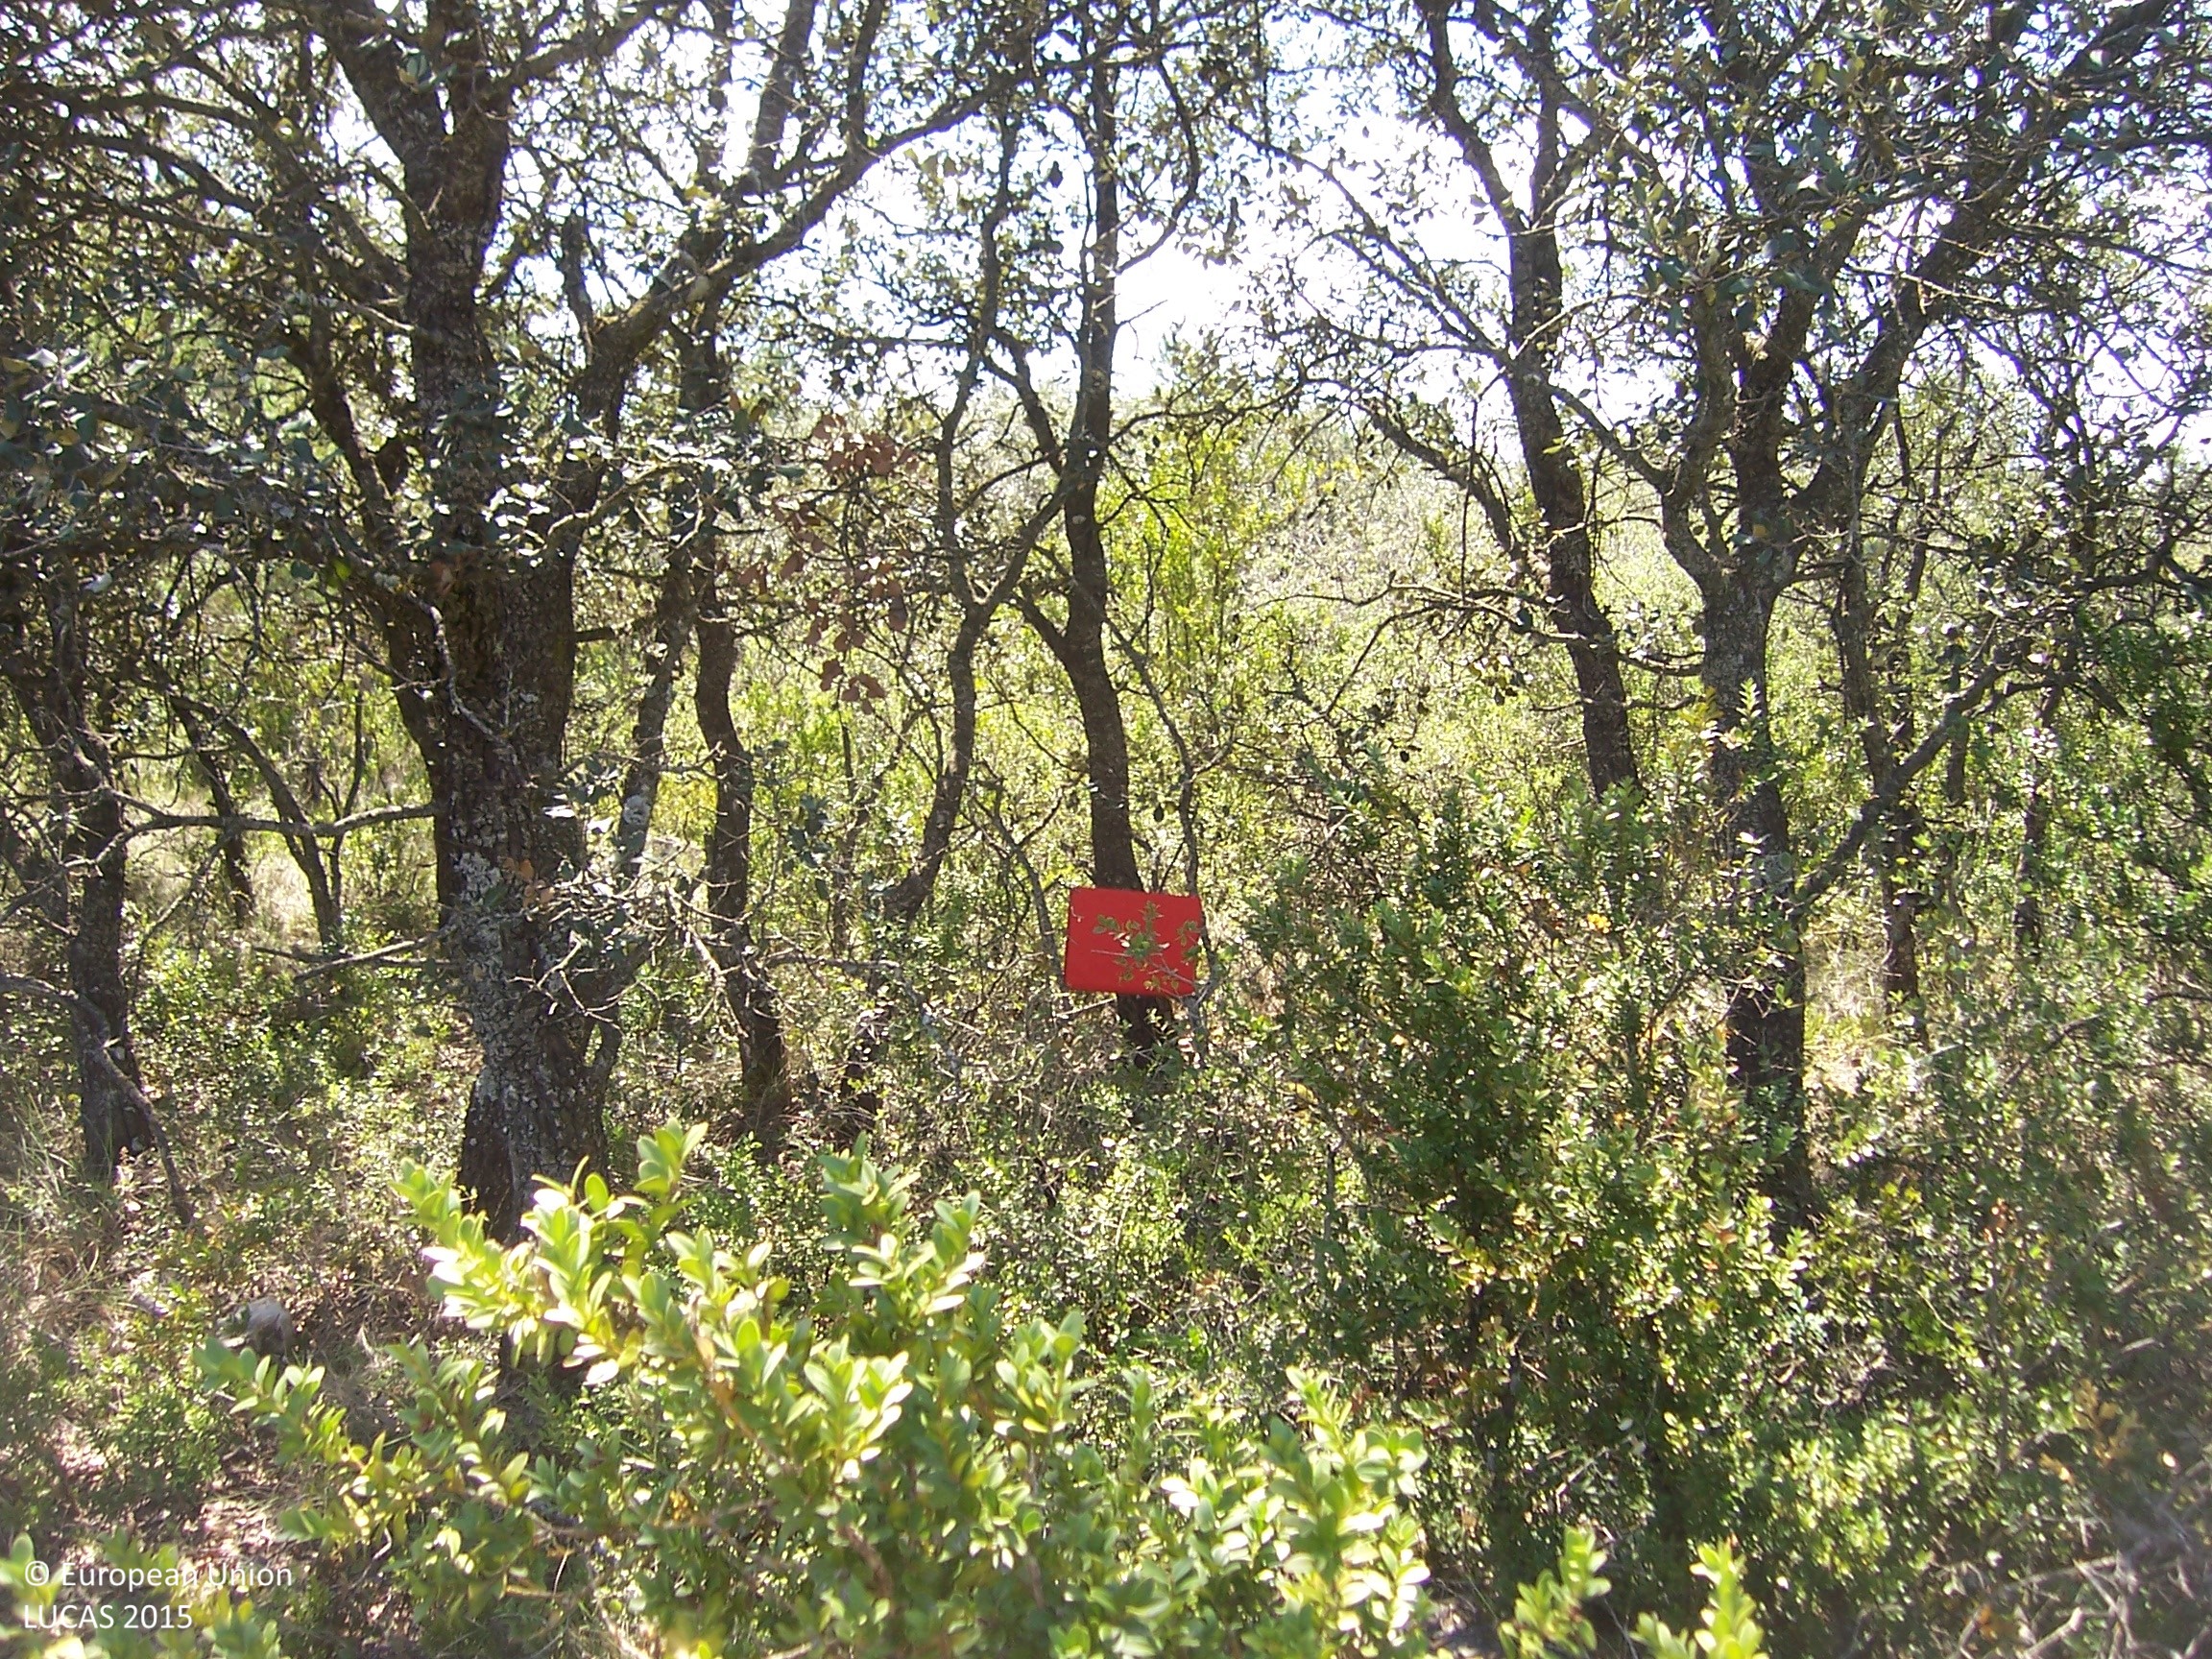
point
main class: Woodland
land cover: Pine dominated mixed woodland
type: coniferous forest of the mediterranean region
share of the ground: > 75 %
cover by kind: coniferous forest trees 40 %, broadleaved forest trees 30 %, shrubs 20 %, herbaceous plants 10 %
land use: Semi-natural and natural areas not in use
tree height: > 5 m
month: August
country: ES
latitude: 41.9580
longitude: 0.5621
